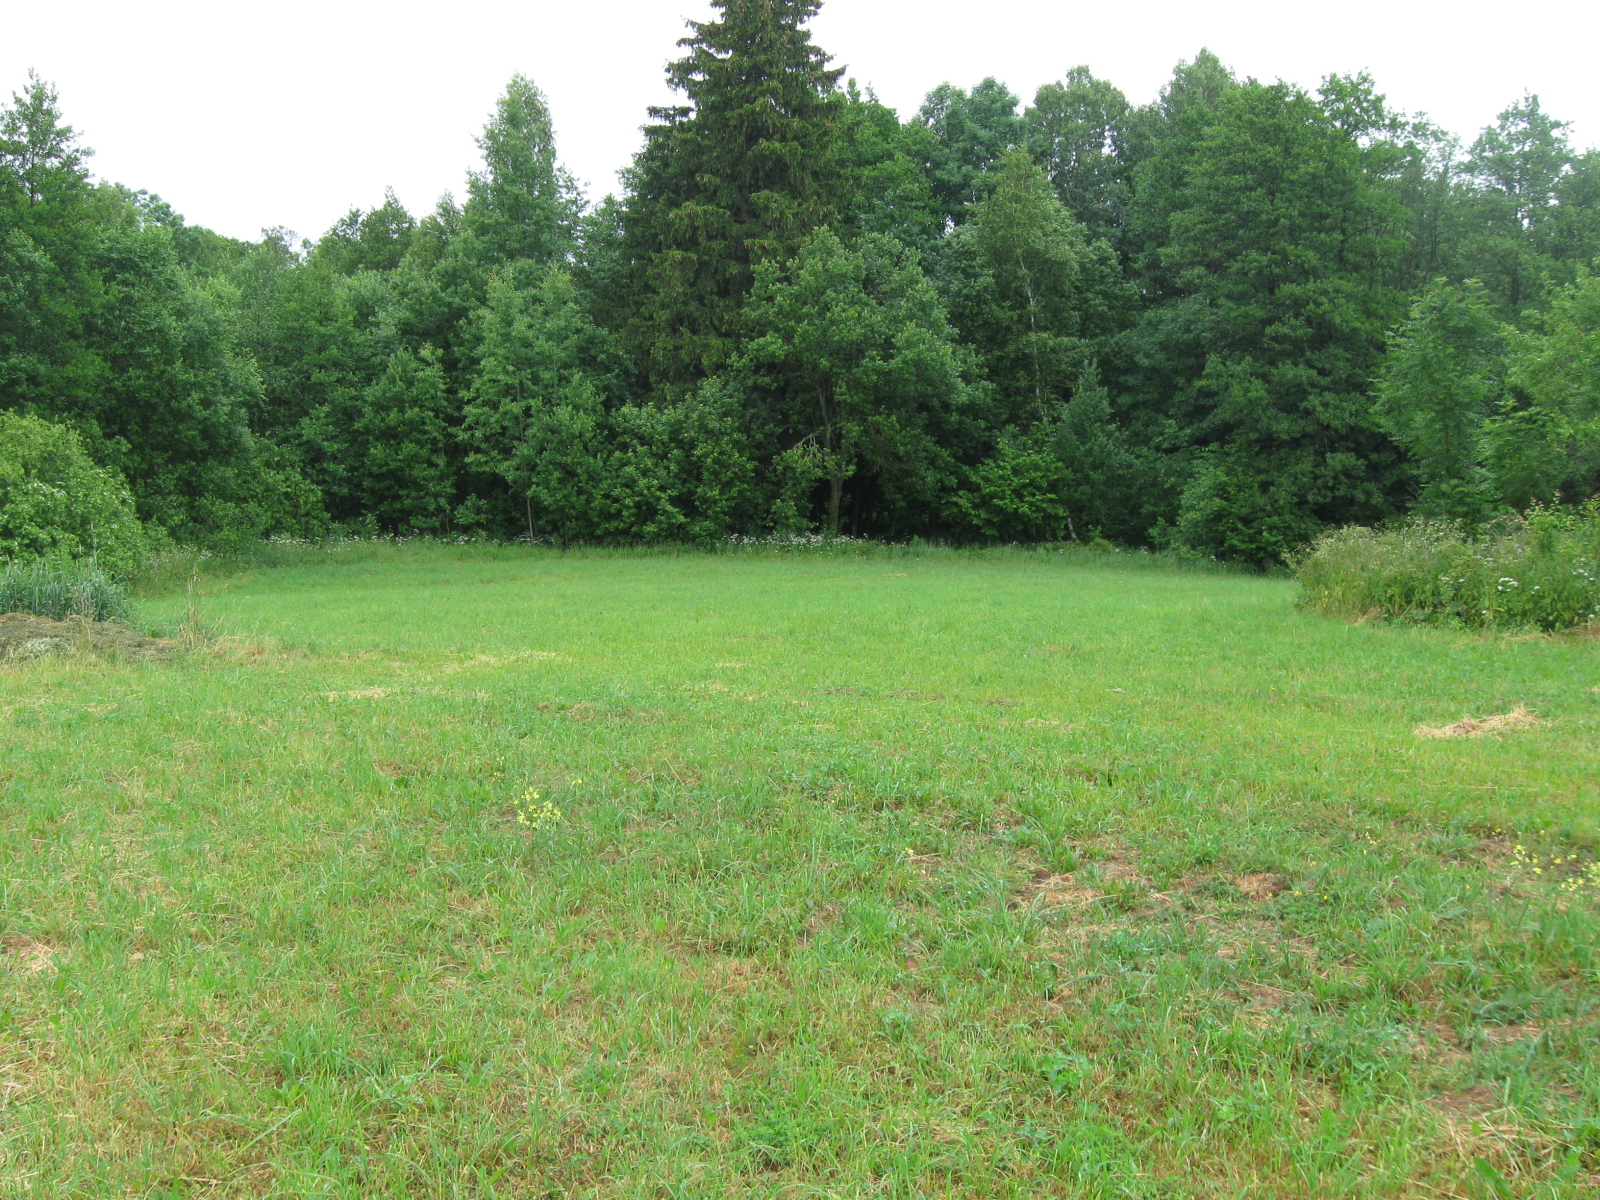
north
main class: Cropland
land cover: Apple fruit
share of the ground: < 10 %
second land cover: Grassland without tree/shrub cover
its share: > 75 %
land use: Agriculture (excluding fallow land and kitchen gardens)
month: June
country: LT
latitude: 54.7677
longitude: 24.3840
